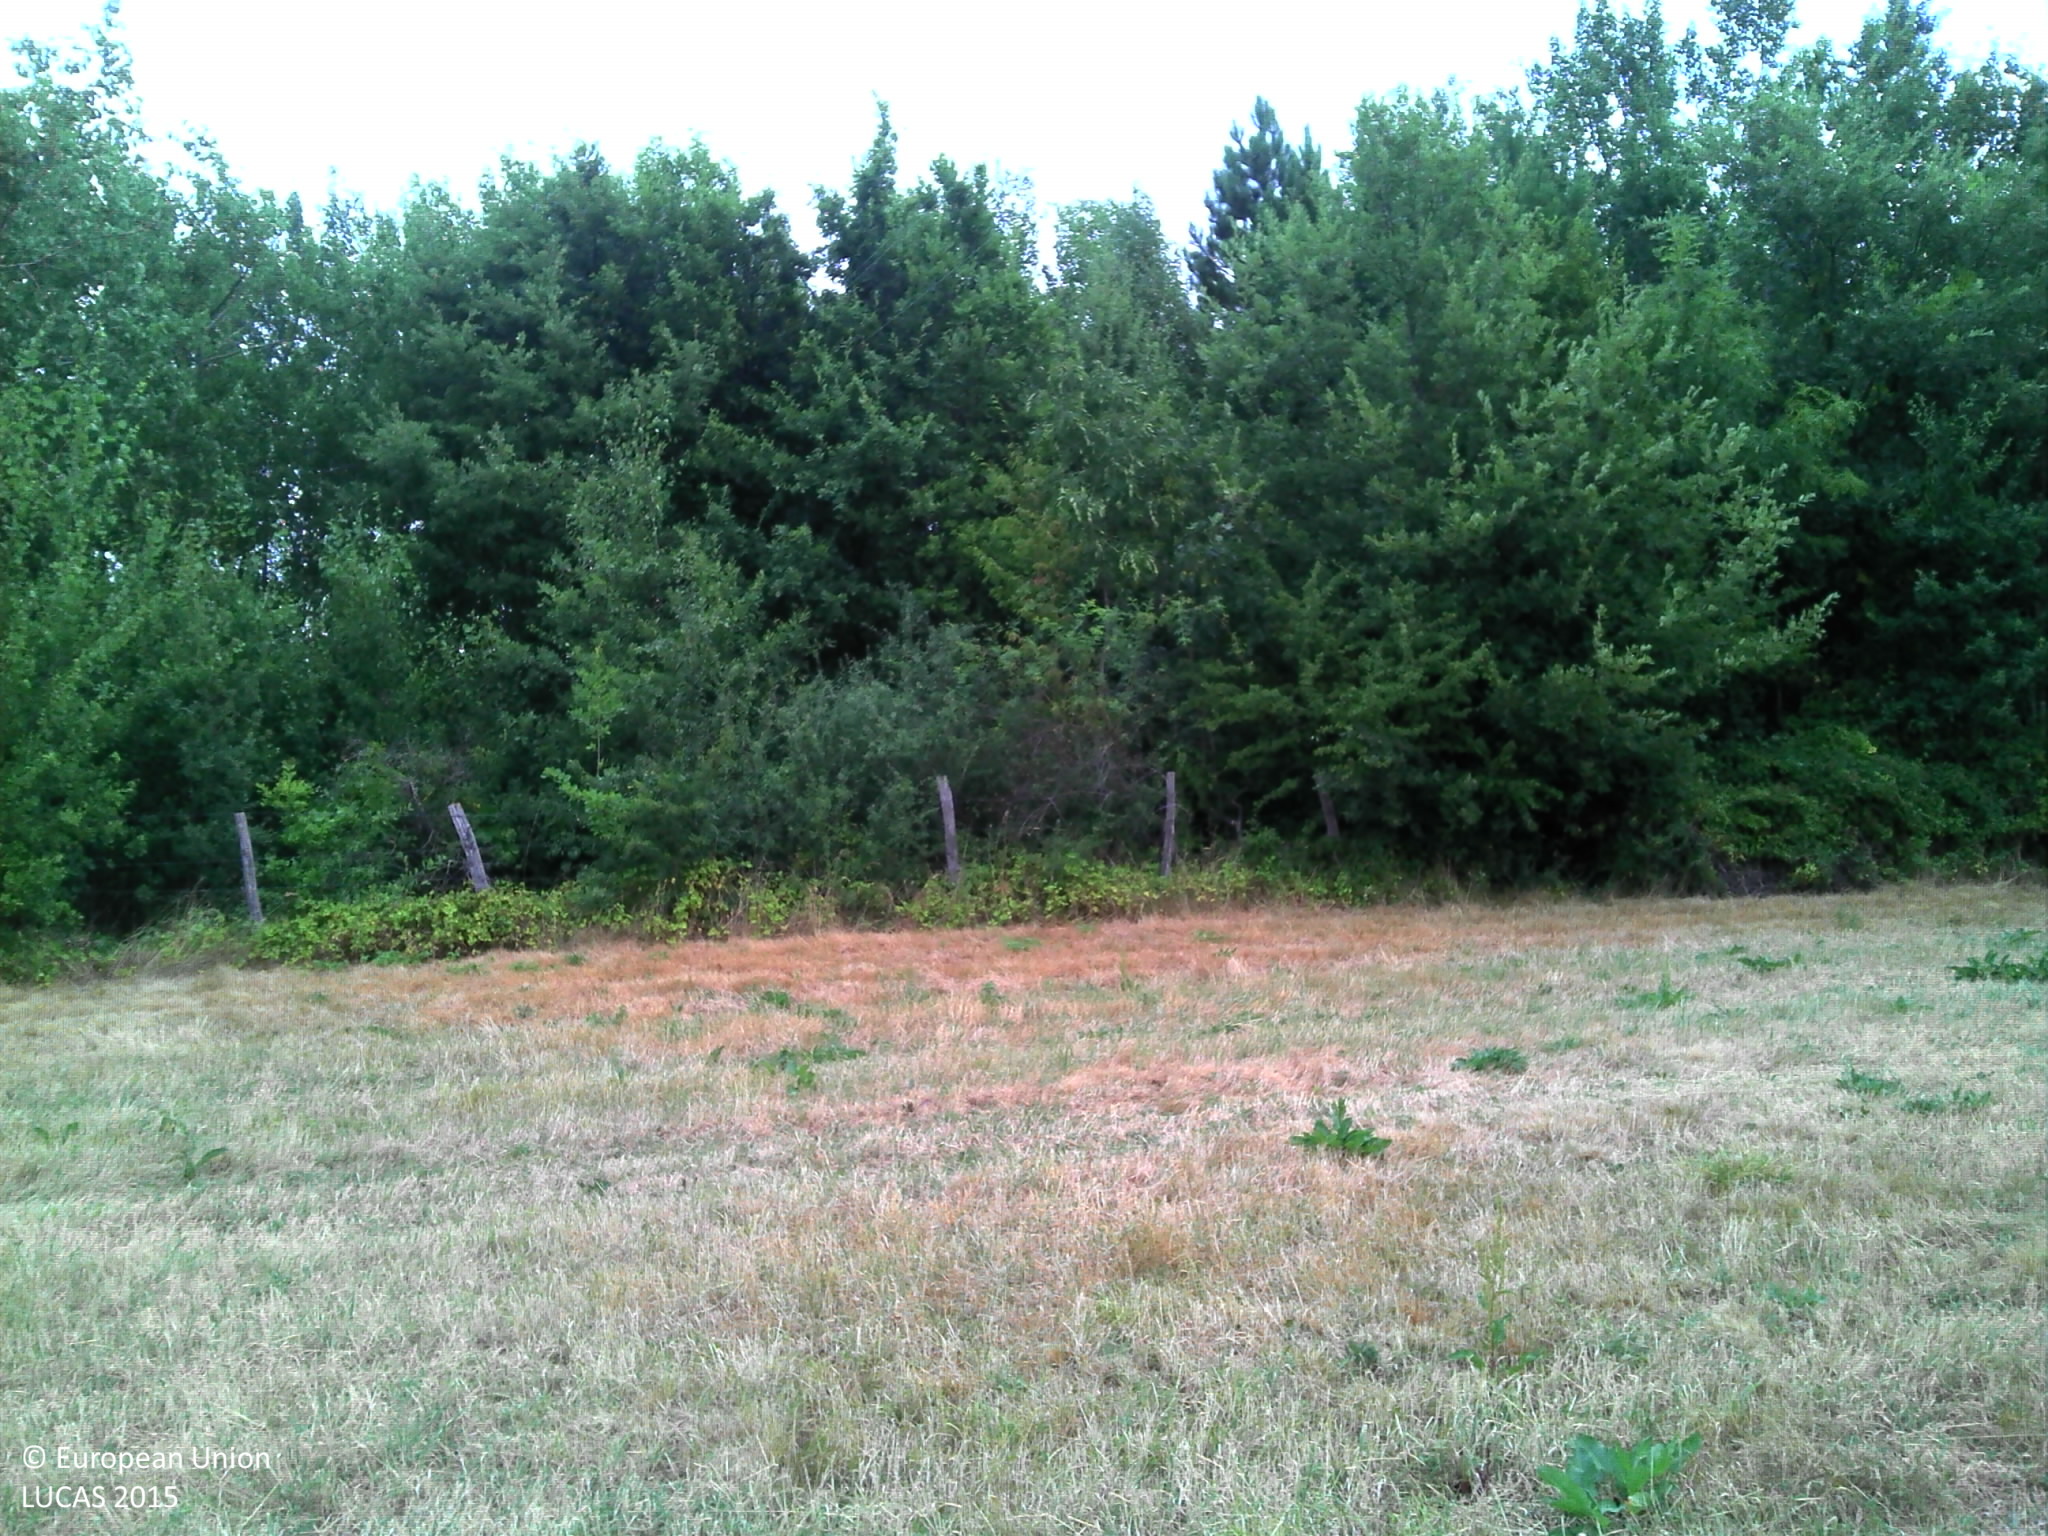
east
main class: Grassland
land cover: Grassland without tree/shrub cover
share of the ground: > 75 %
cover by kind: herbaceous plants 100 %
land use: Agriculture (excluding fallow land and kitchen gardens)
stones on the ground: < 10 %
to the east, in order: Grassland without tree/shrub cover; Electric lines; Fences; Broadleaved woodland; Fences; Grassland without tree/shrub cover; Fences; Lines of trees; Electric lines; Tracks; Fences; Broadleaved woodland; Grassland with sparse tree/shrub cover; Single bushes/trees; Fences; Tracks; Broadleaved woodland
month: July
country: FR
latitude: 45.4584
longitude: 5.0043
